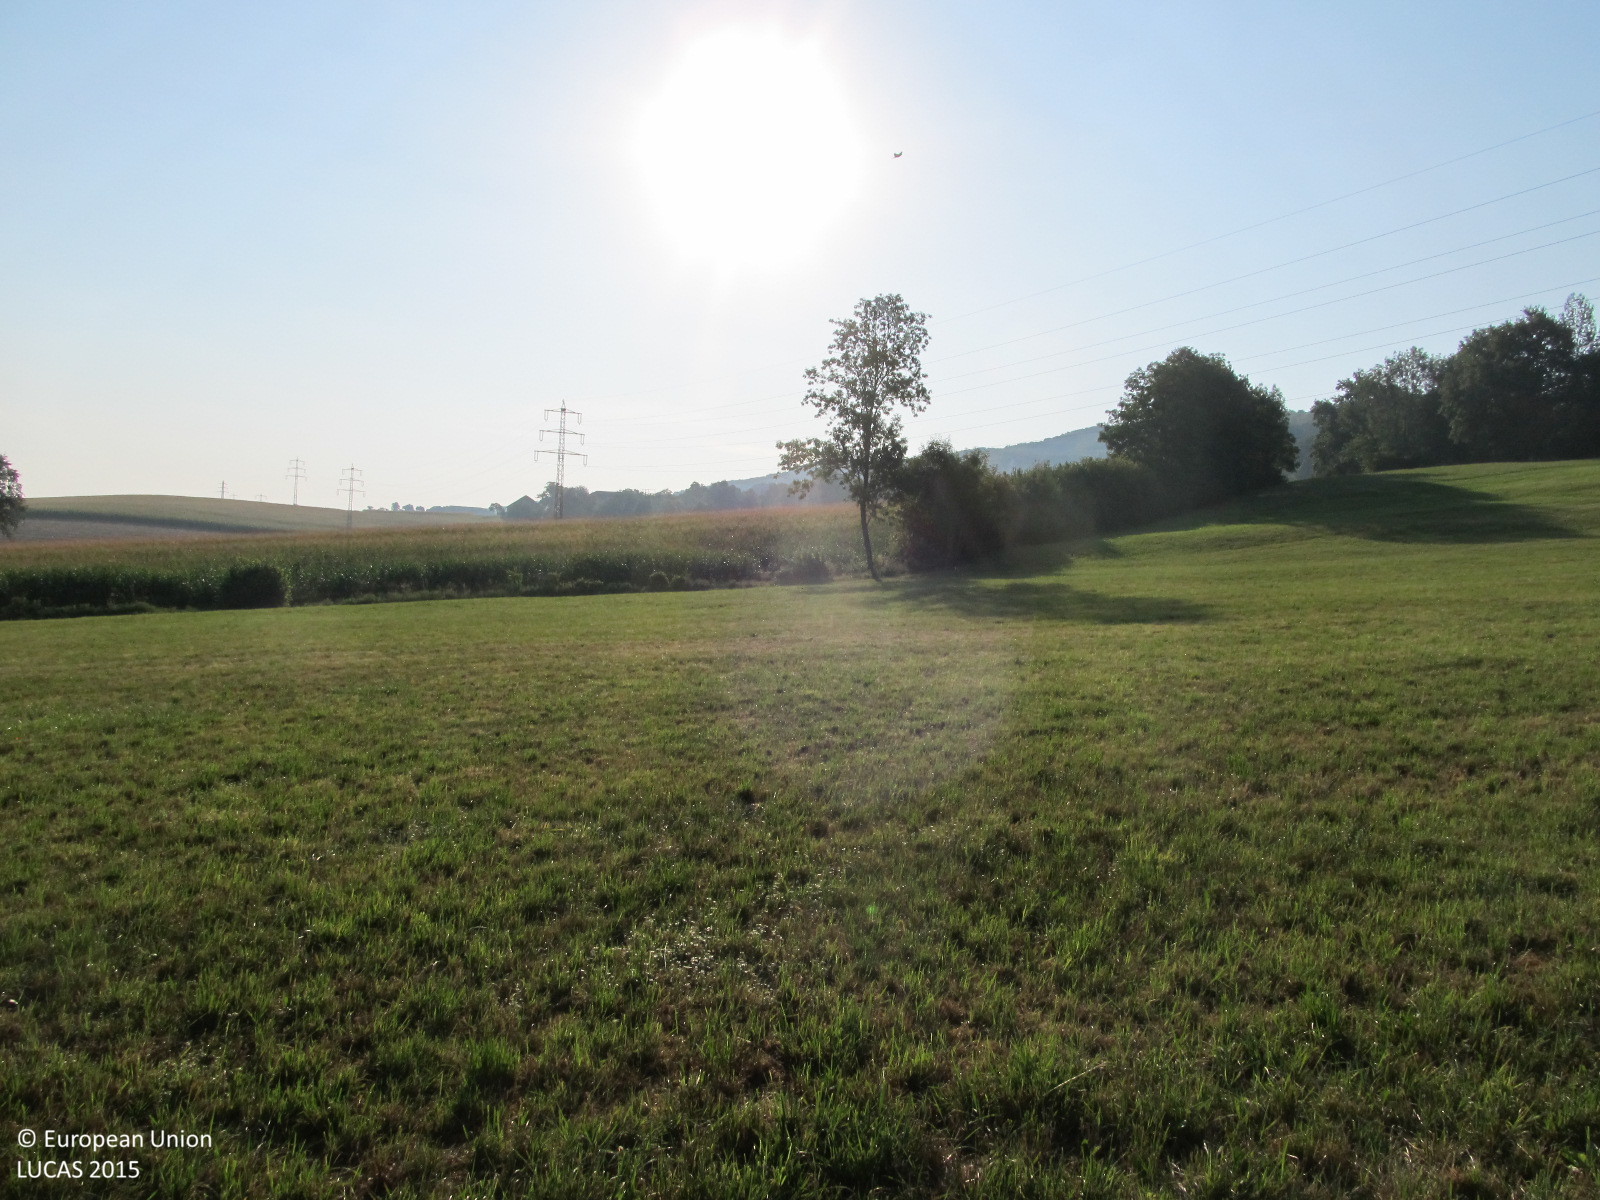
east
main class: Grassland
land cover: Grassland without tree/shrub cover
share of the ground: > 75 %
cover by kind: herbaceous plants 100 %
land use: Agriculture (excluding fallow land and kitchen gardens)
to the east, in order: Grassland without tree/shrub cover; Broadleaved woodland; Maize; Electric lines; Maize; Barley; Maize
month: August
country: AT
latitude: 48.1072
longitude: 15.4413
